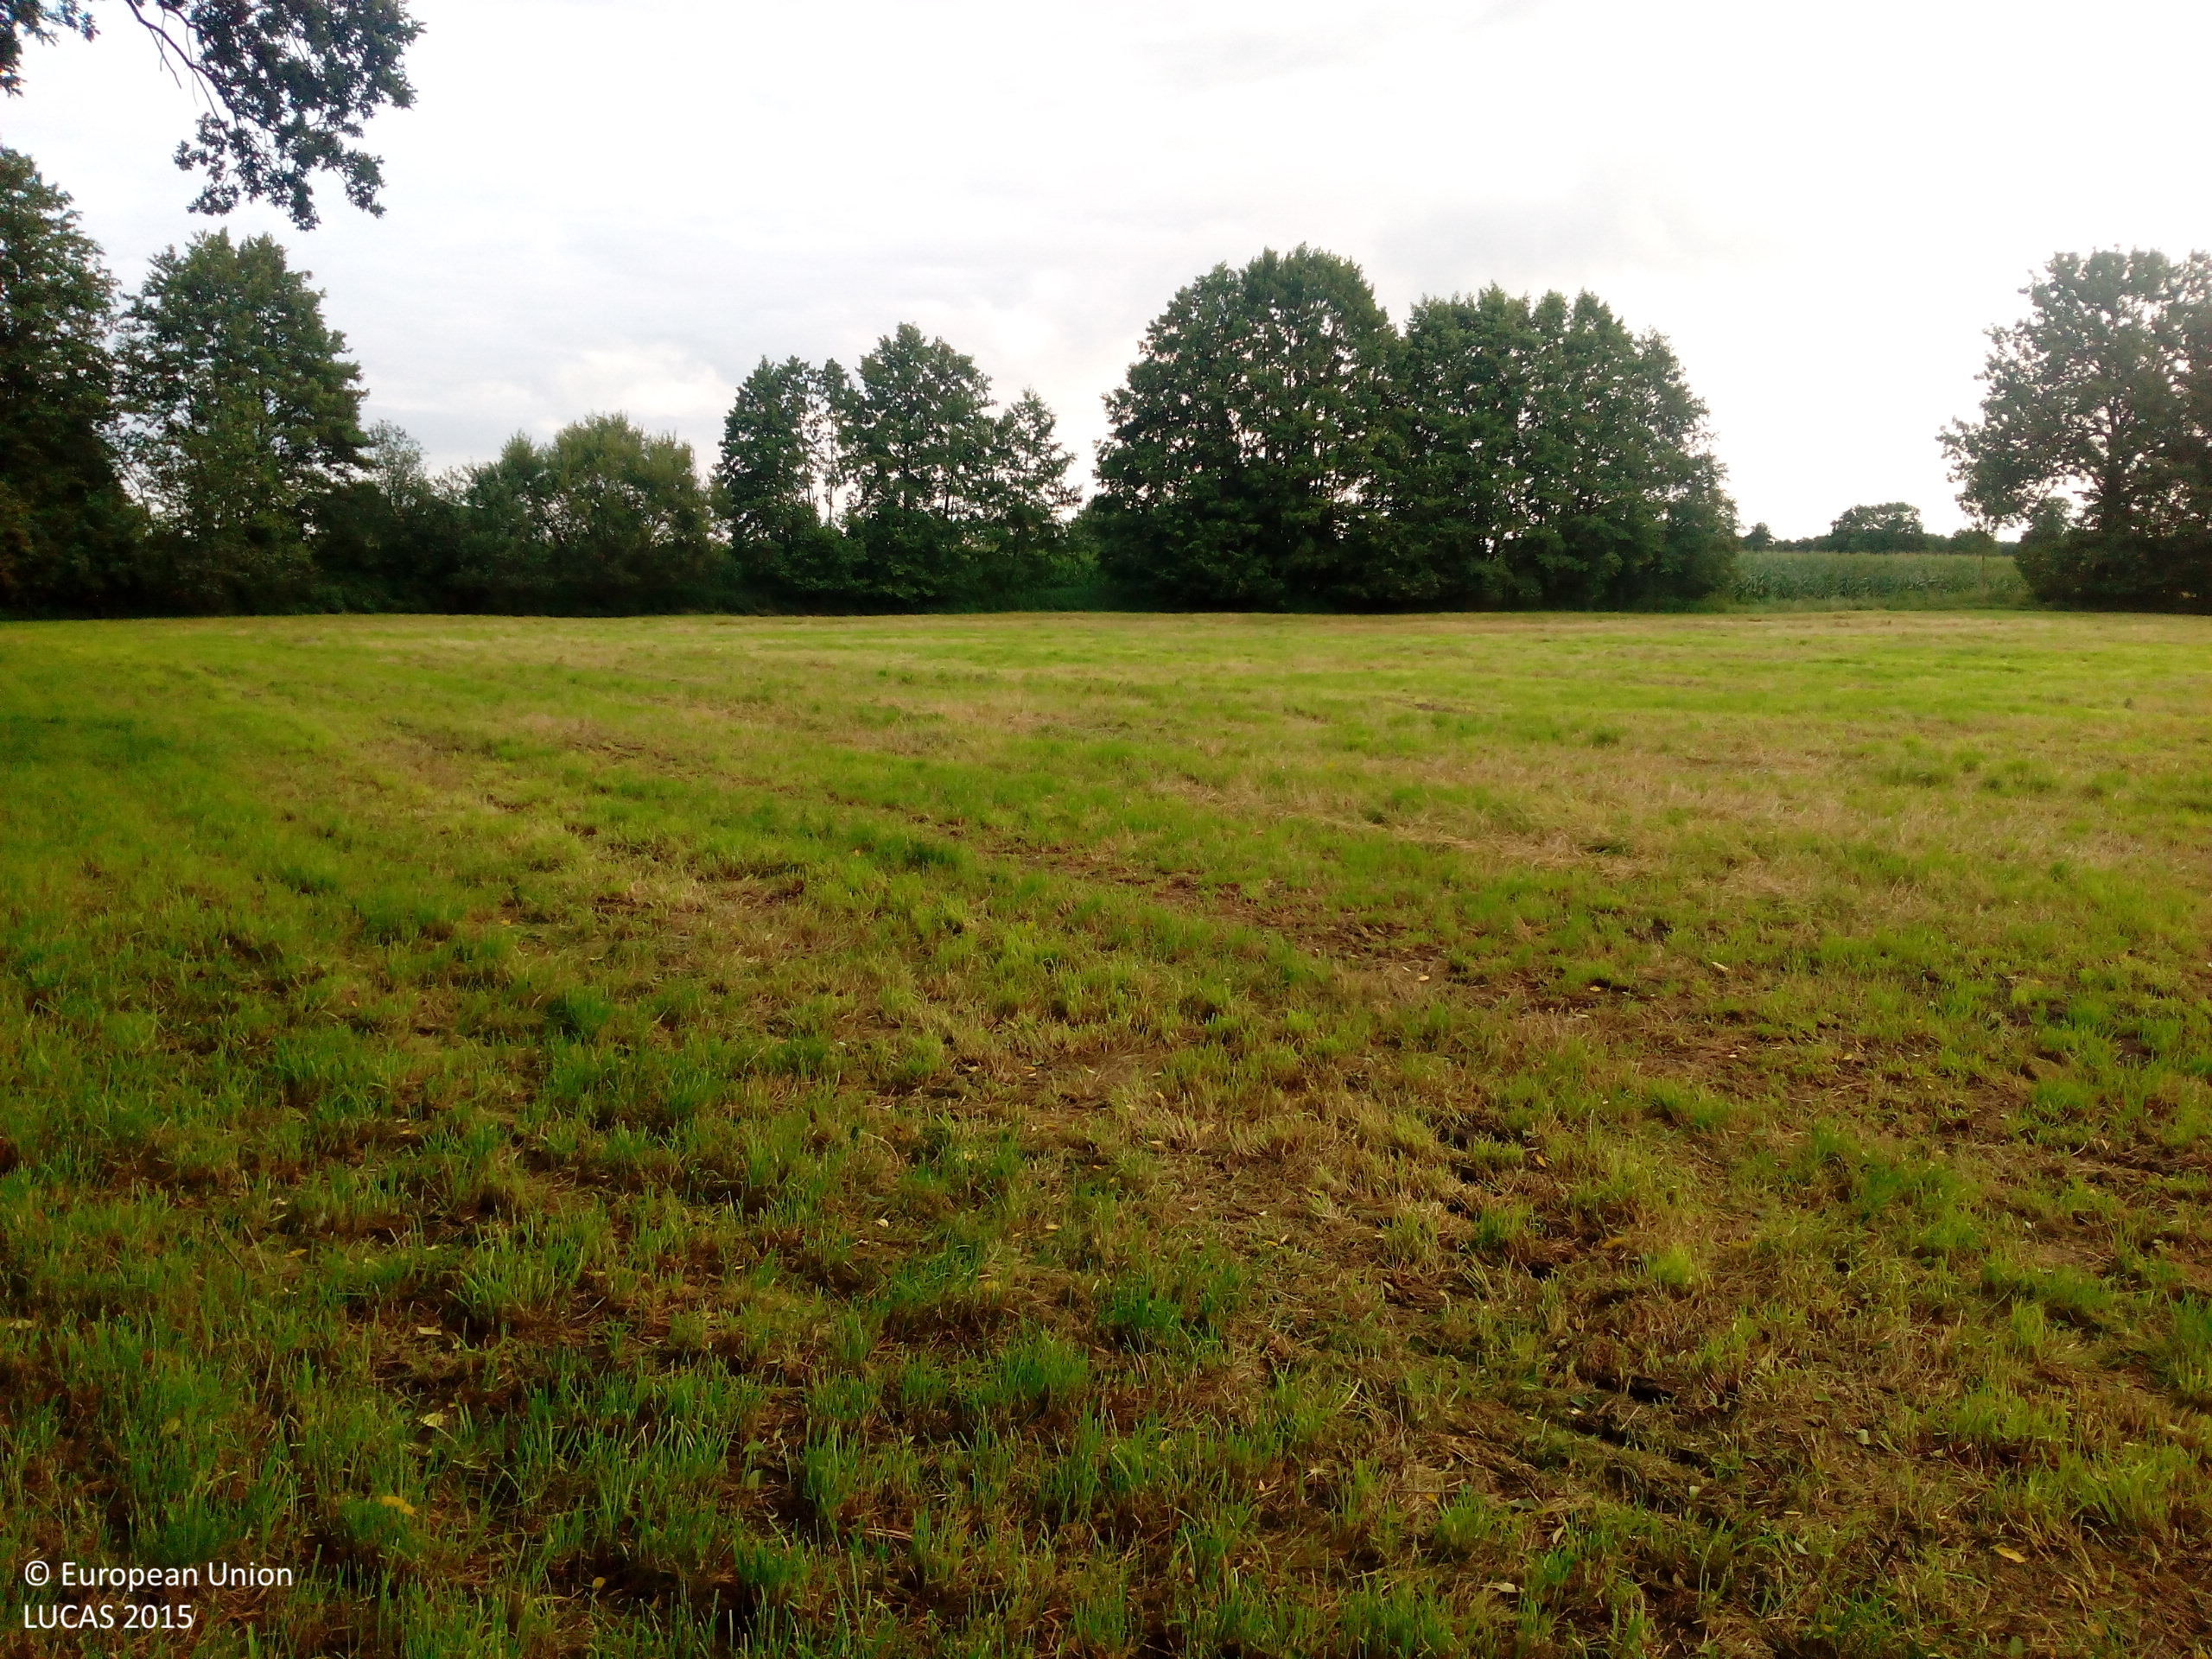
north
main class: Grassland
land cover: Grassland without tree/shrub cover
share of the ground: > 75 %
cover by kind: herbaceous plants 80 %, unconsolidated bare surface 20 %
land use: Agriculture (excluding fallow land and kitchen gardens)
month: August
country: DE
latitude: 53.8692
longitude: 9.9240
